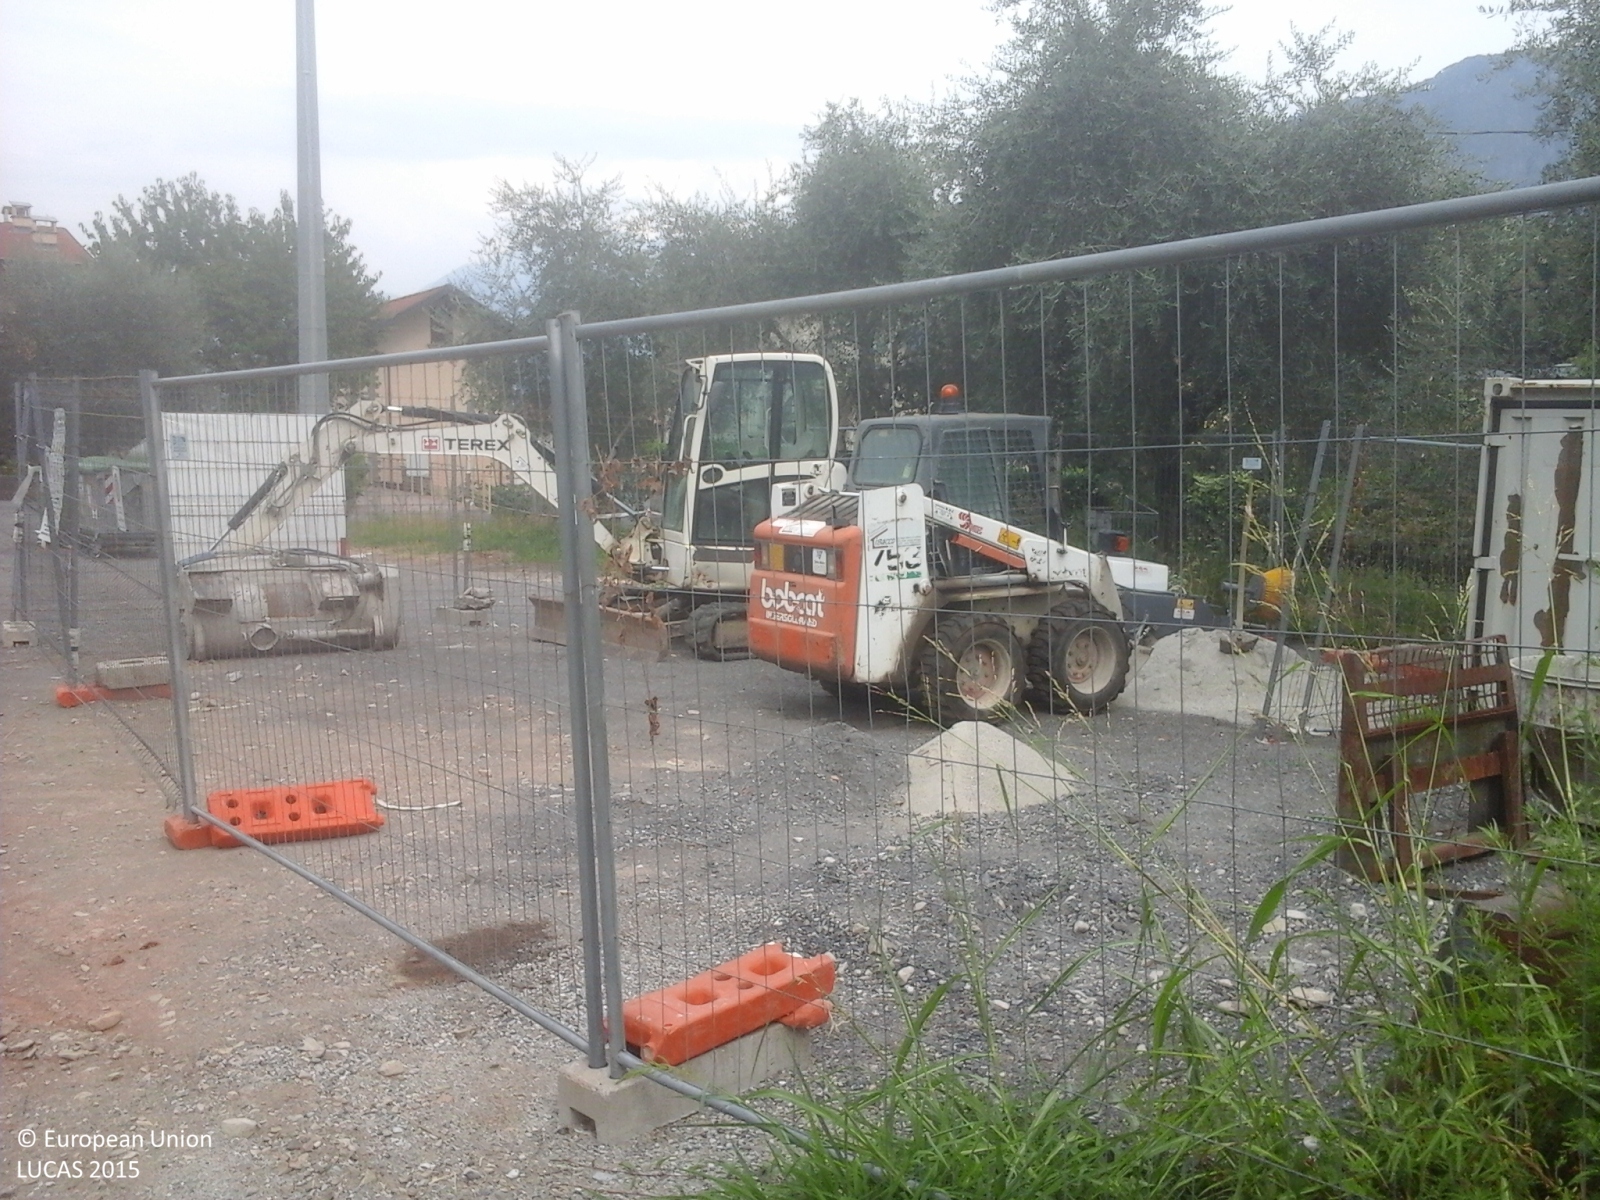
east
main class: Grassland
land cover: Grassland without tree/shrub cover
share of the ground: > 75 %
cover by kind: herbaceous plants 100 %
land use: Residential
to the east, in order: Grassland without tree/shrub cover; Artificial constructions in urban areas
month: August
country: IT
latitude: 45.9698
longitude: 9.1882
